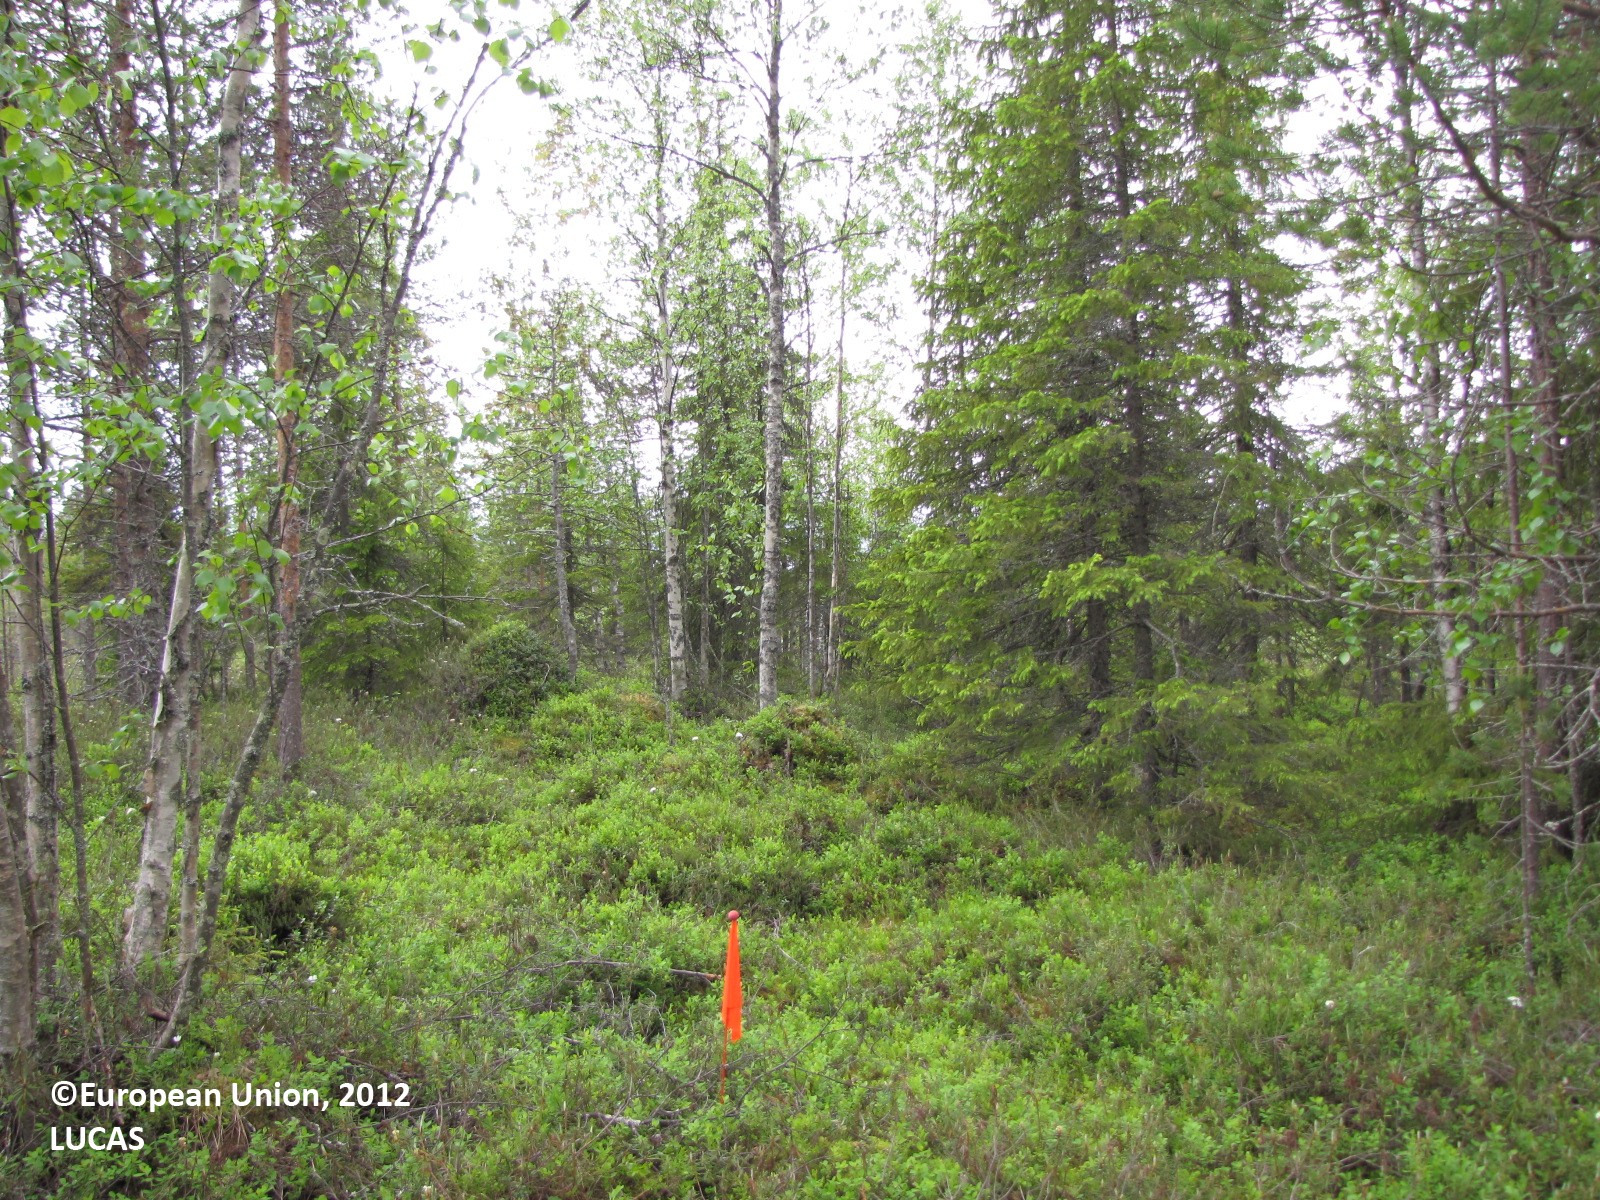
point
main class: Woodland
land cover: Other mixed woodland
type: boreal forest
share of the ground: 50 - 75 %
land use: Forestry
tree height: > 5 m
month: June
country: FI
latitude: 66.1278
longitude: 24.6902
